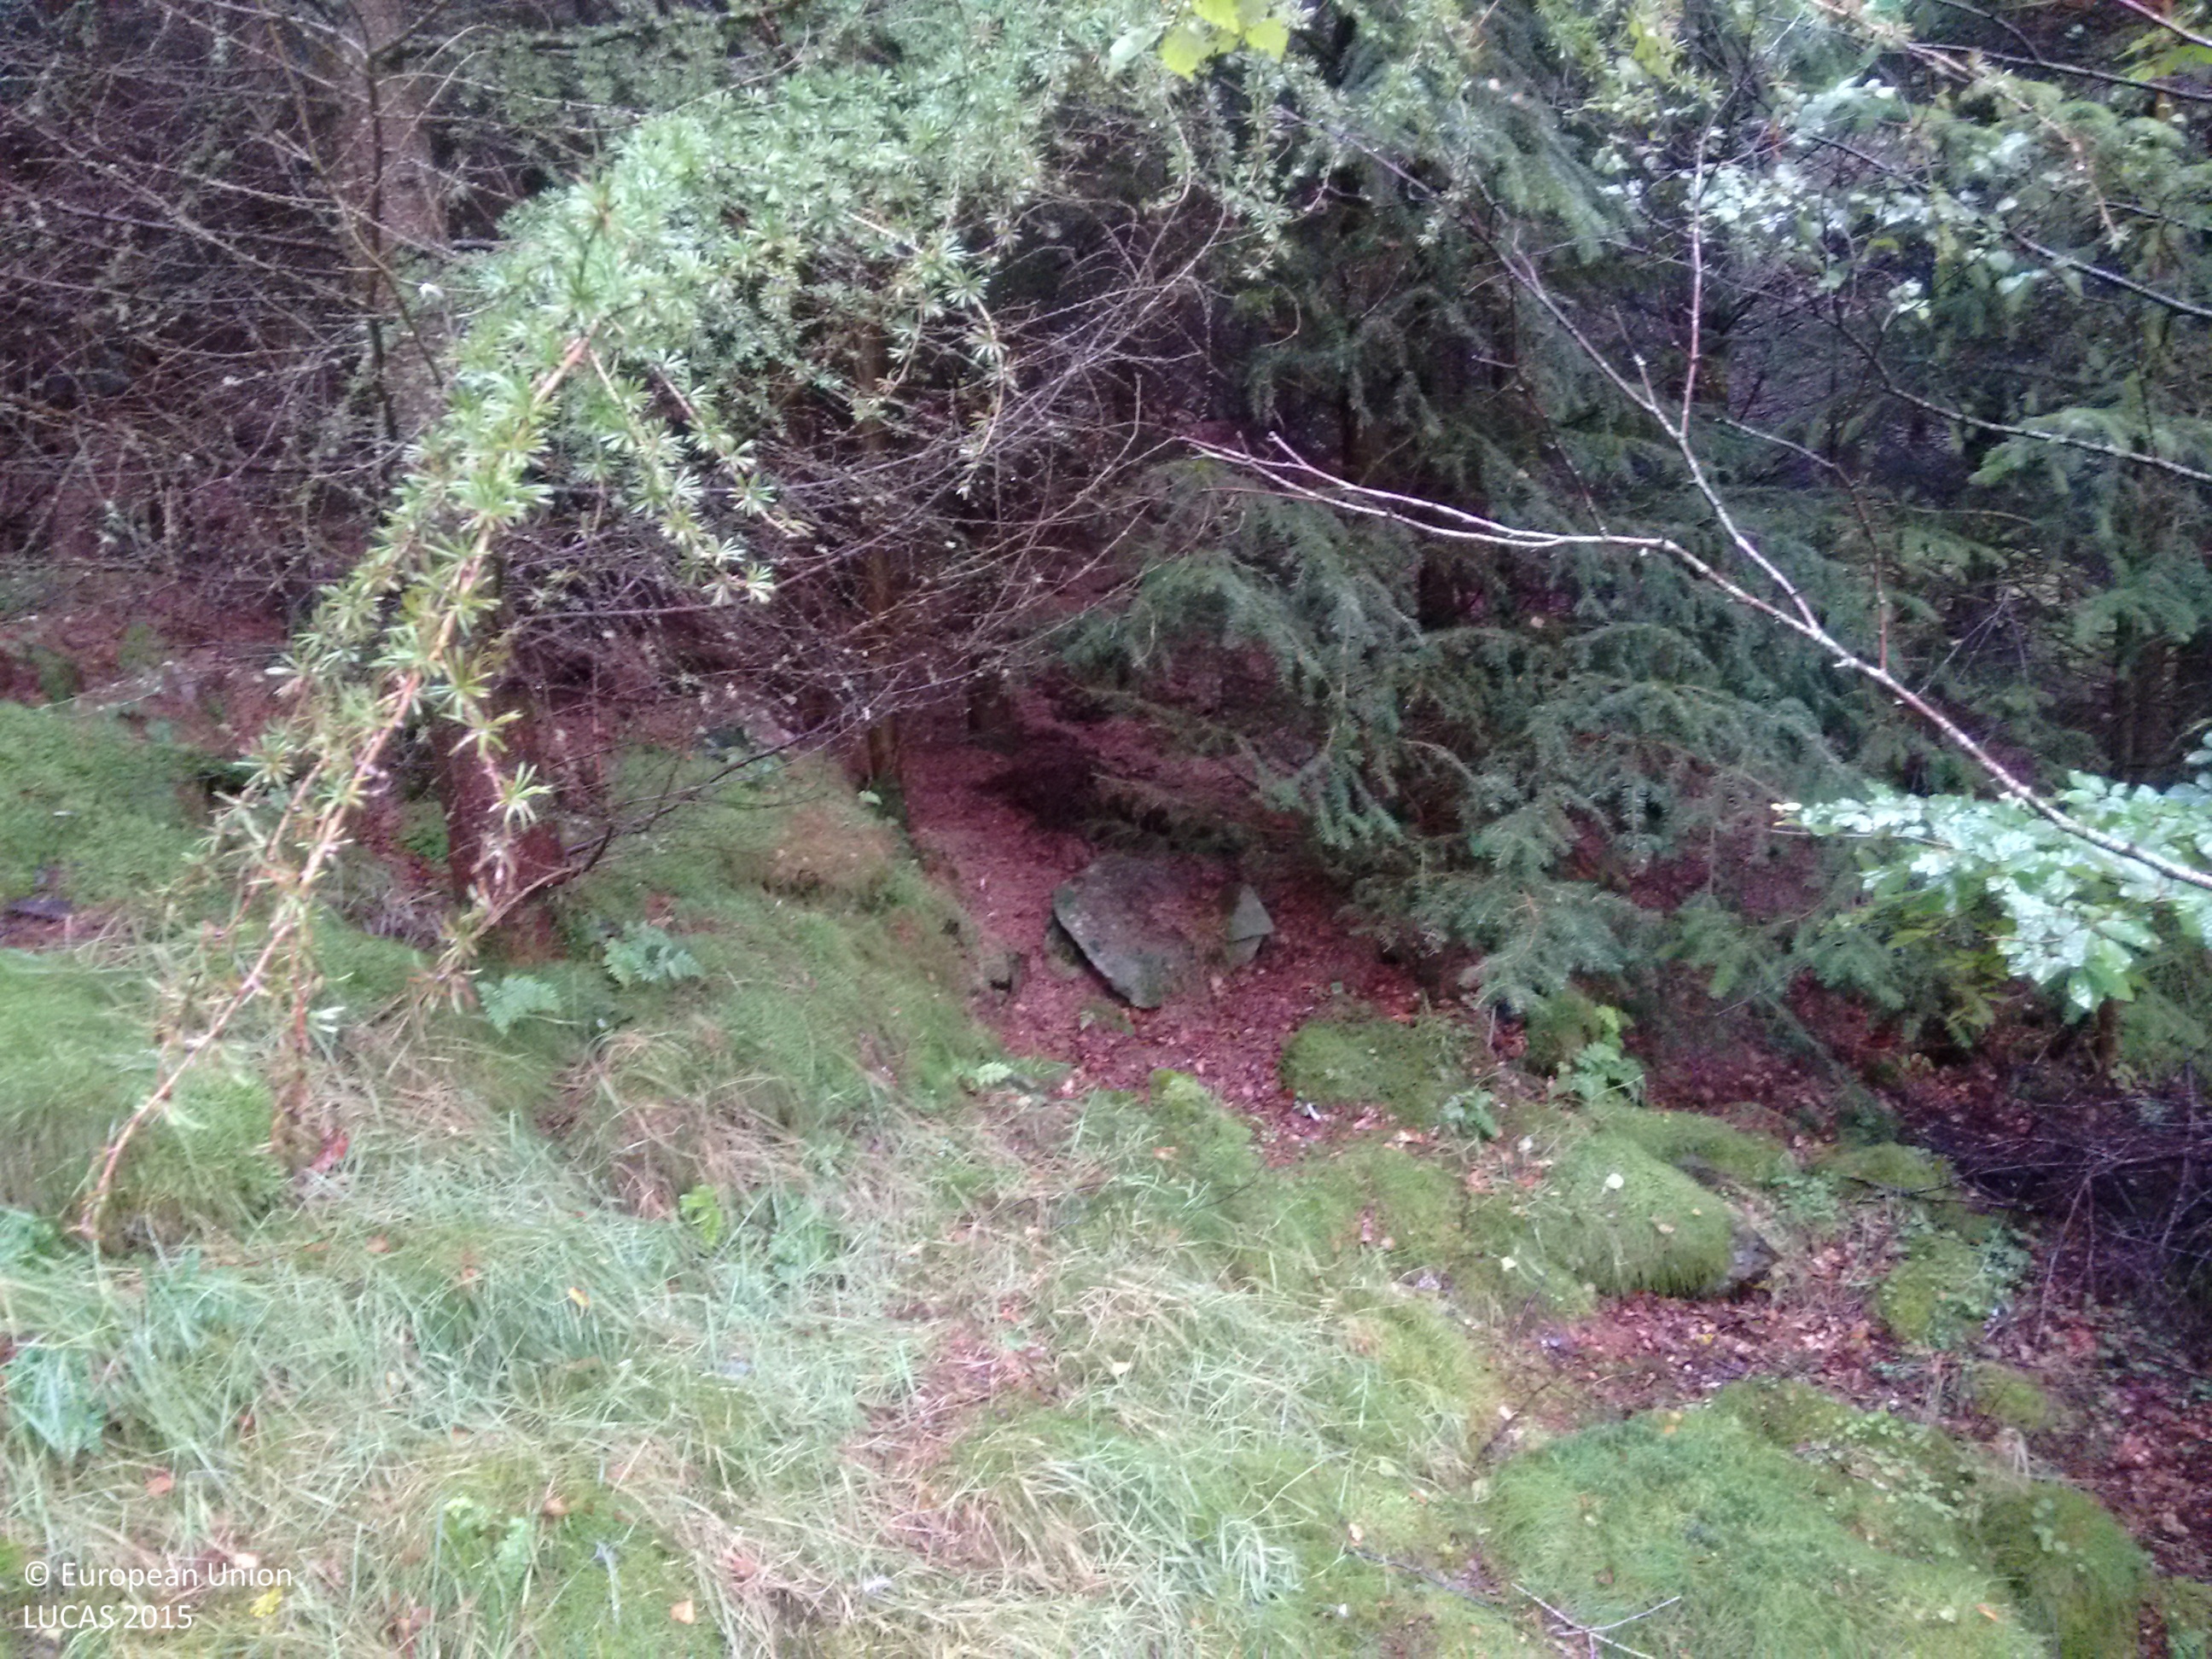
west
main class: Woodland
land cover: Spruce dominated mixed woodland
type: exotic forest
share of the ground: > 75 %
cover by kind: coniferous forest trees 60 %, broadleaved forest trees 35 %, herbaceous plants 5 %
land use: Forestry
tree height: > 5 m
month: August
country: GB
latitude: 57.4369
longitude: -2.2599
